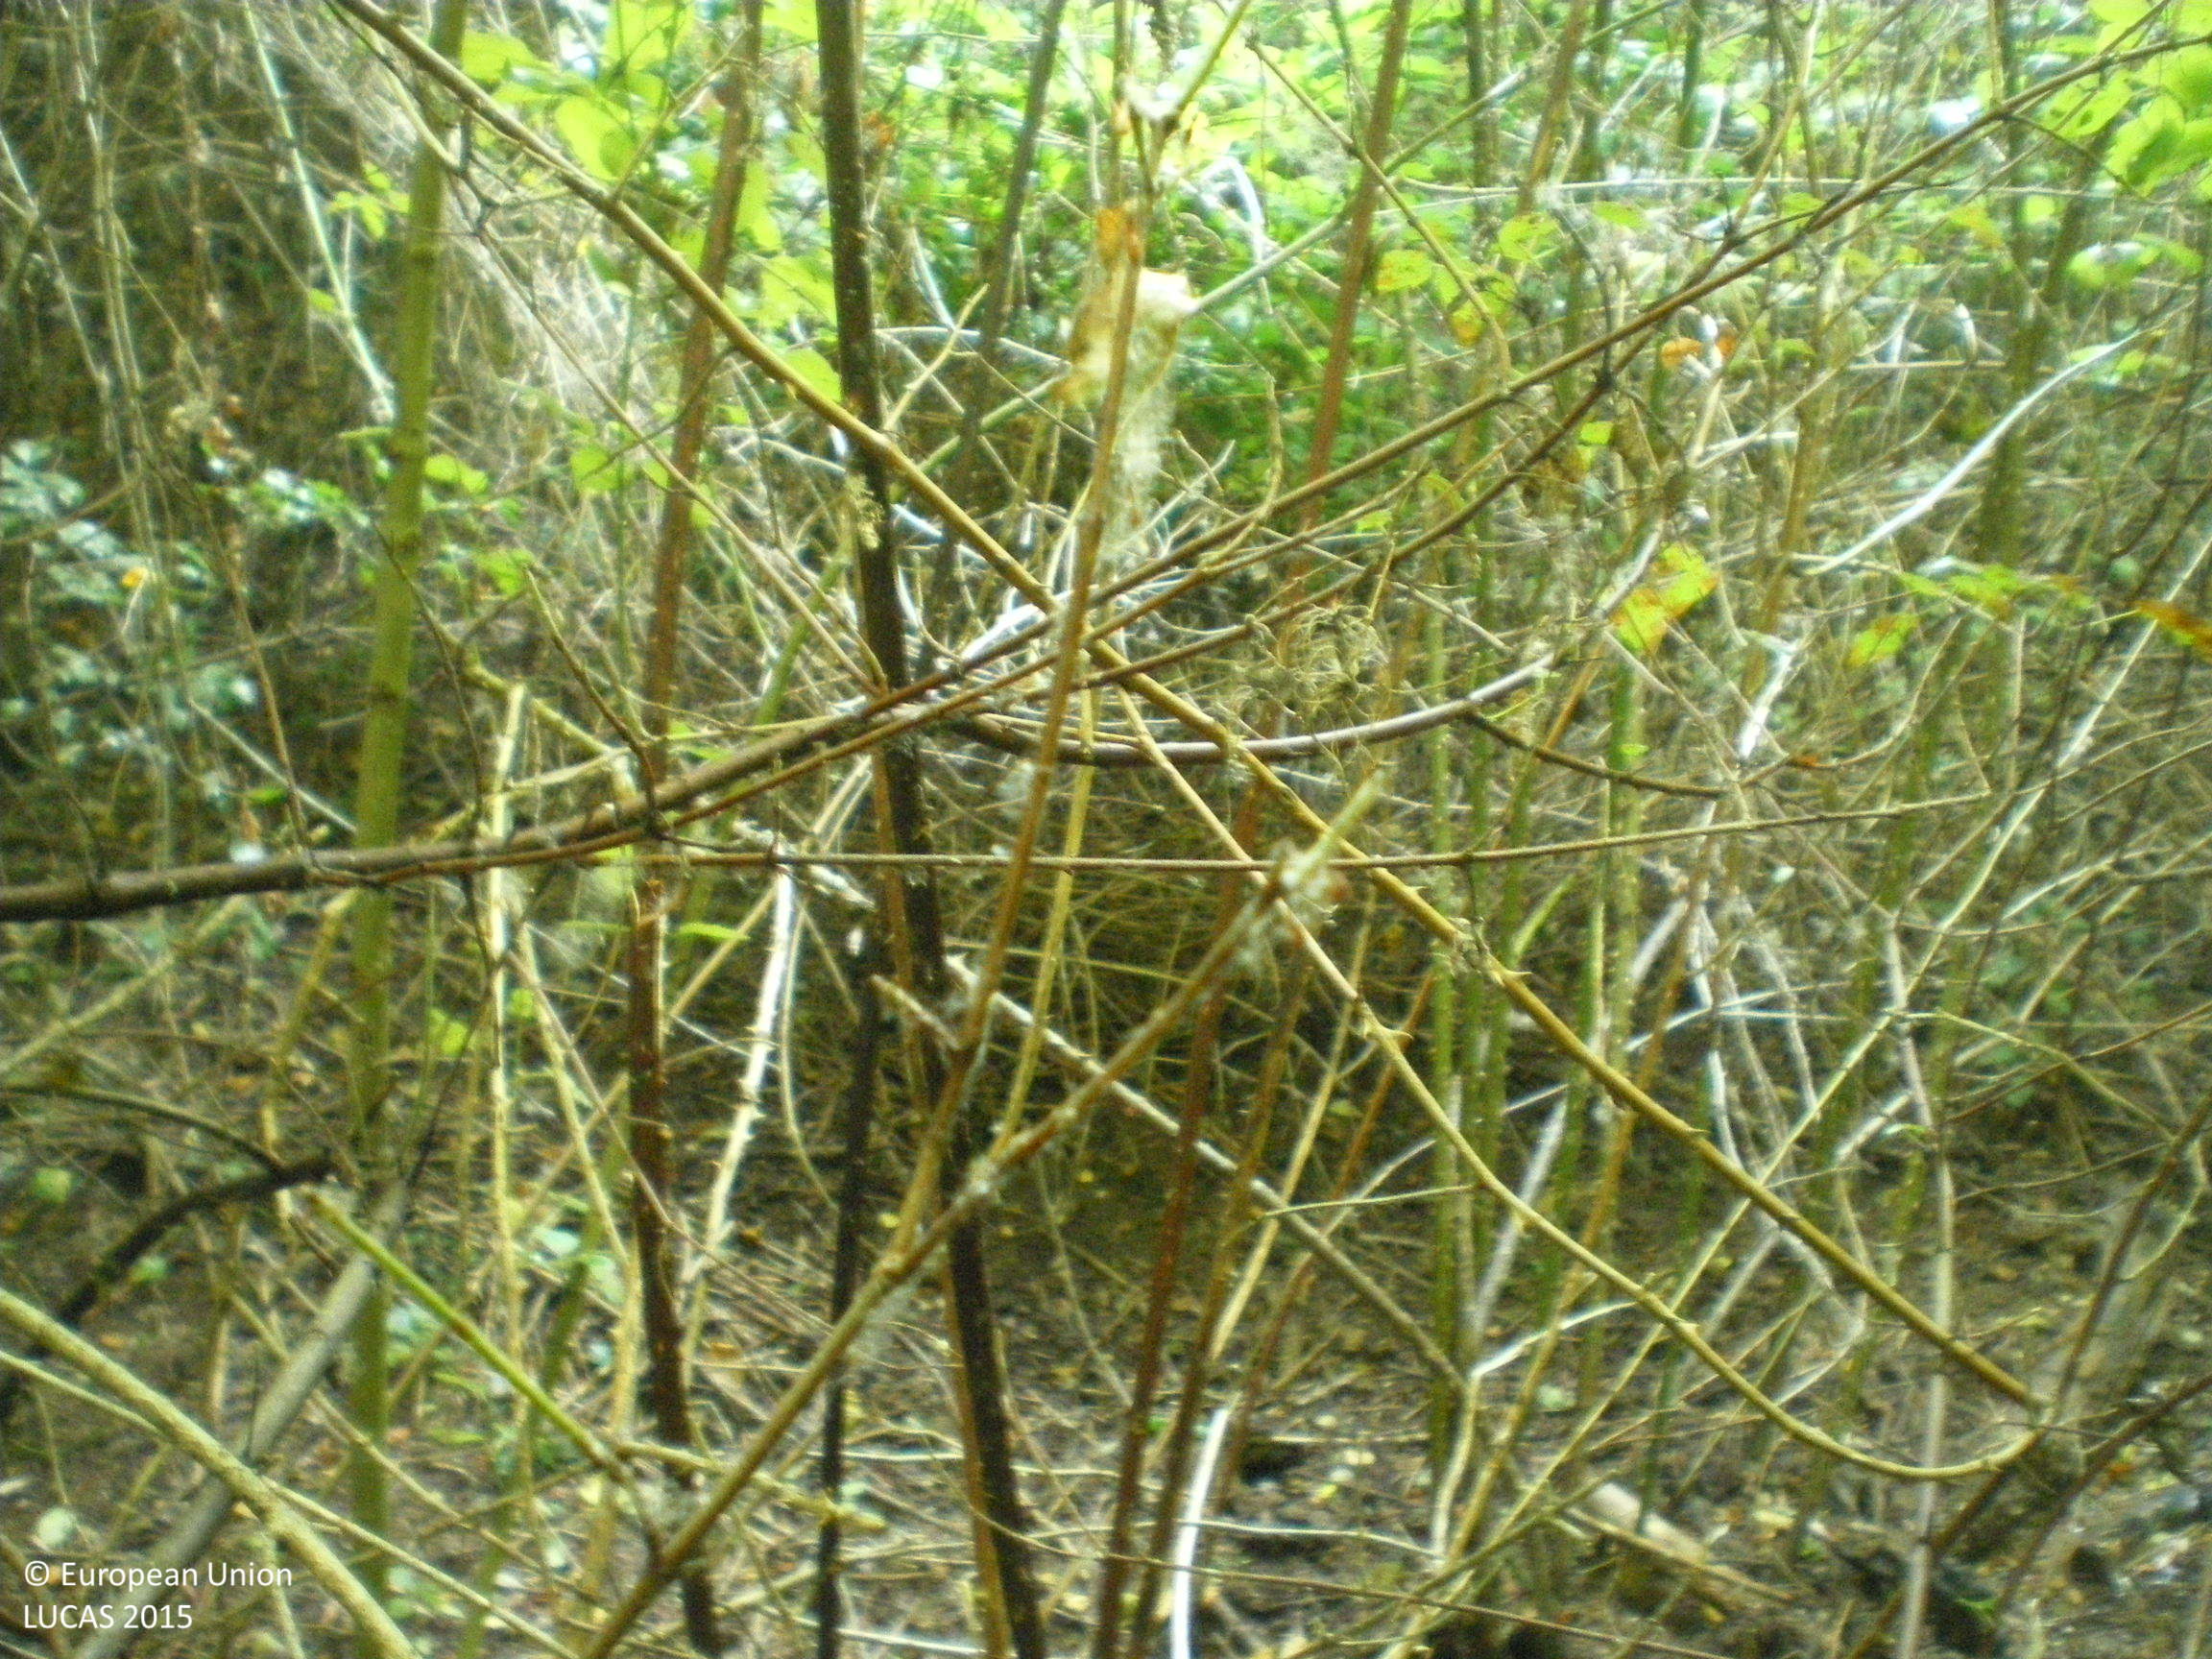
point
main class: Woodland
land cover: Broadleaved woodland
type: mesophytic deciduous forest
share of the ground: > 75 %
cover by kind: broadleaved forest trees 100 %
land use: Forestry
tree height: > 5 m
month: August
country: BG
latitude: 42.3910
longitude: 25.4836
